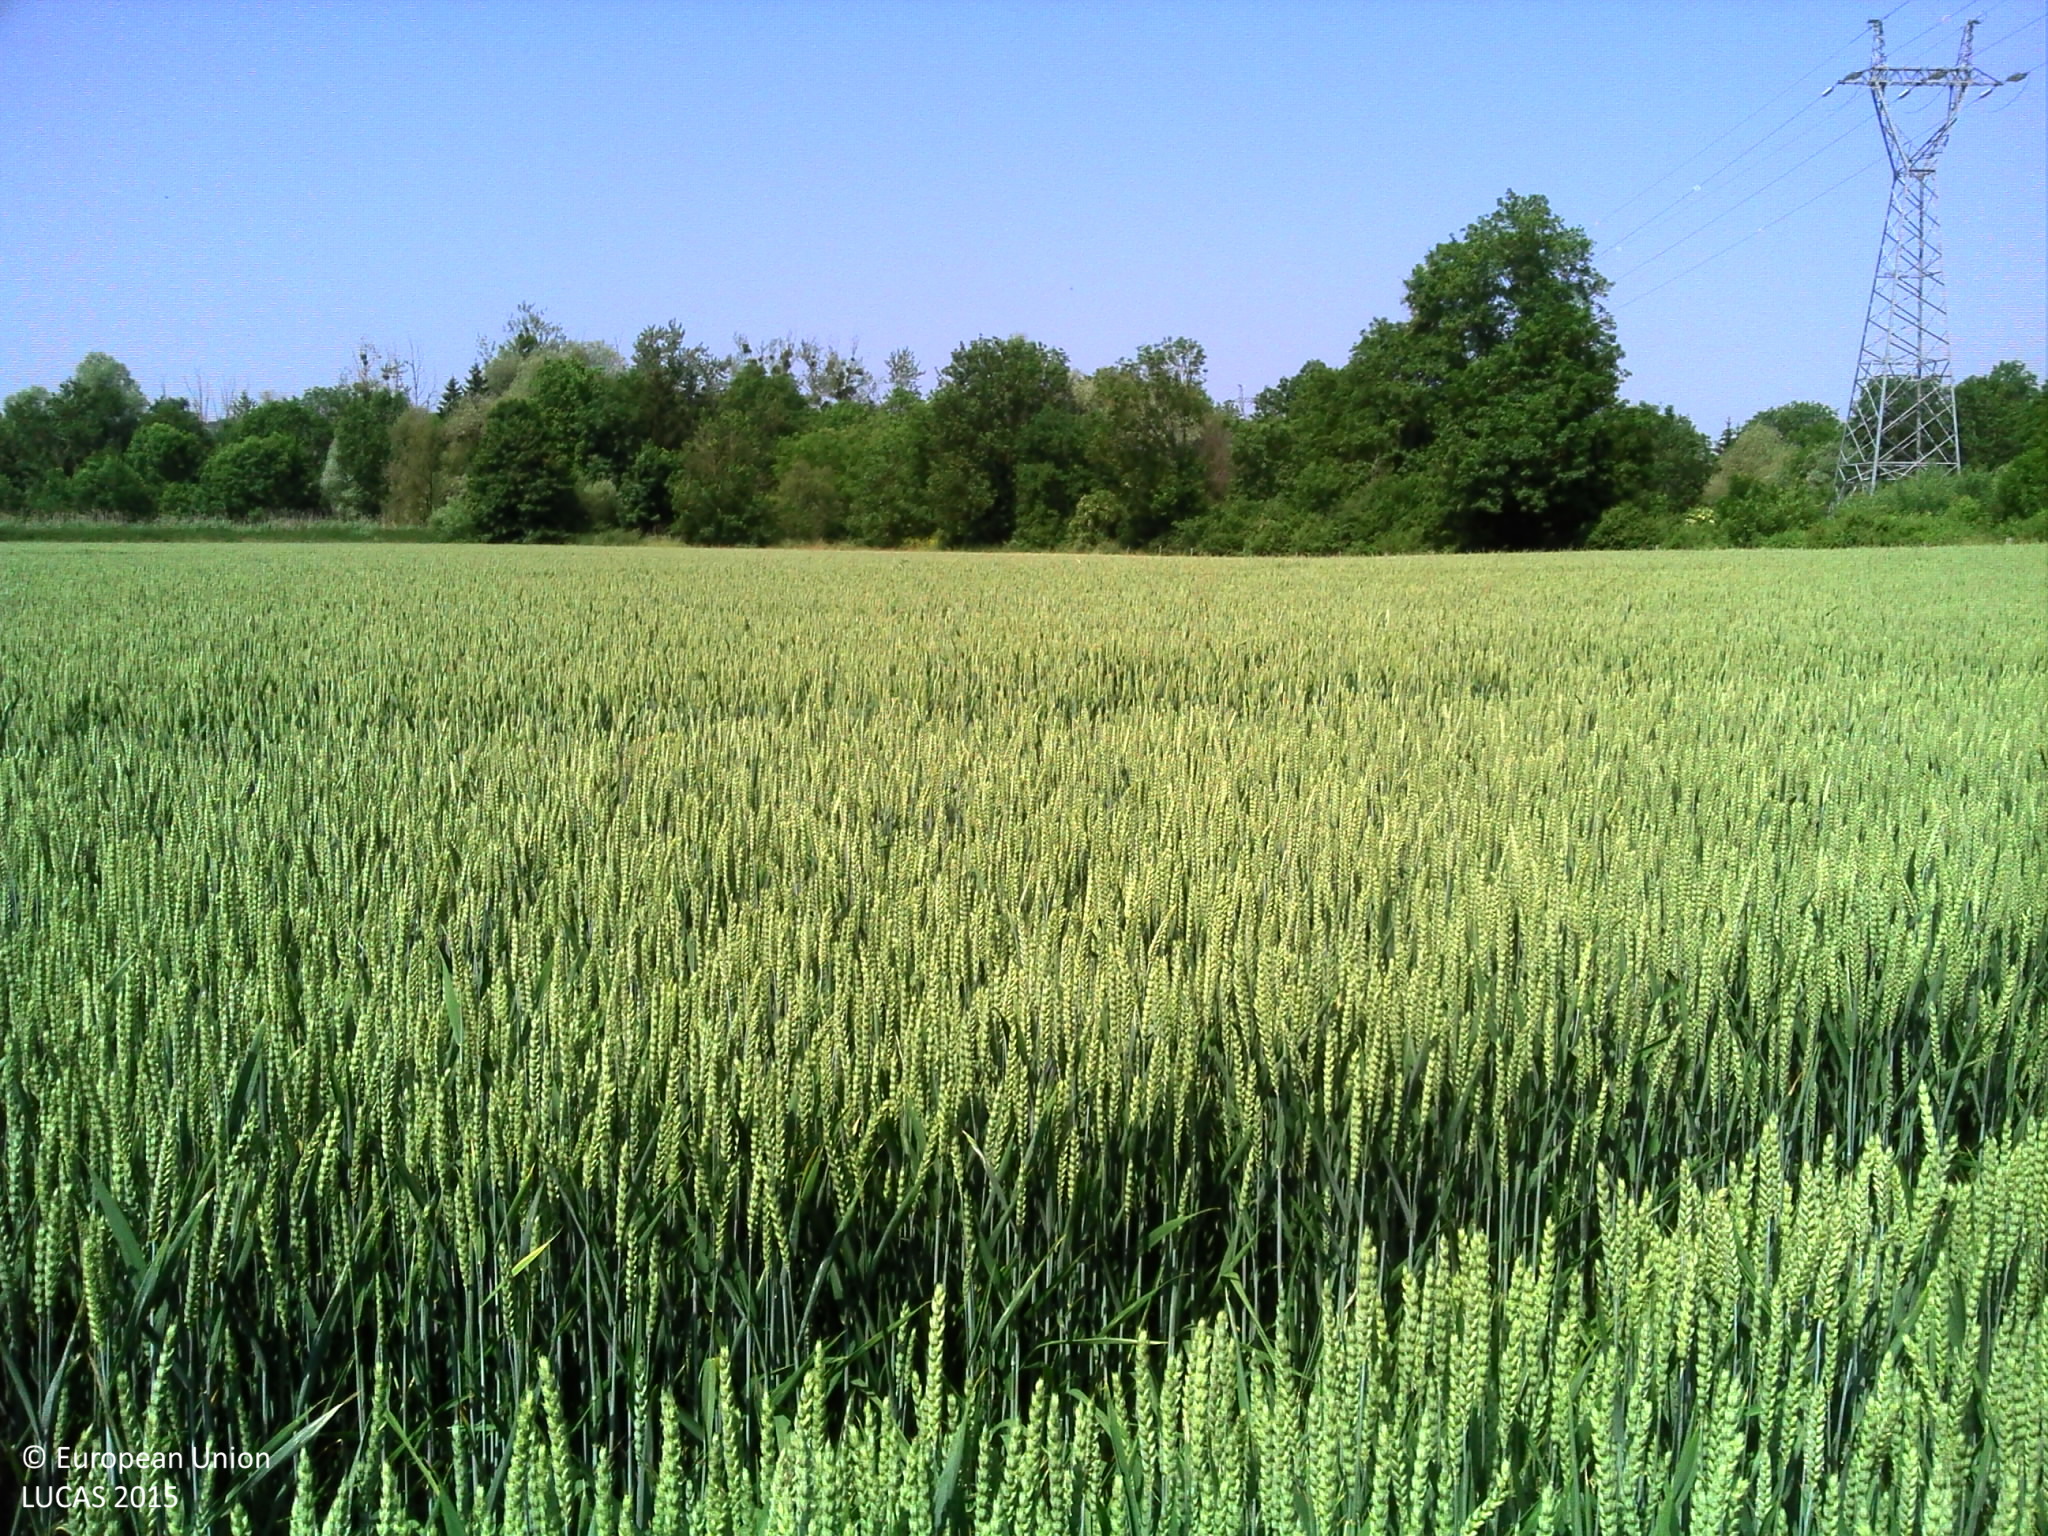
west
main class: Cropland
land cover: Common wheat
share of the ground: > 75 %
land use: Agriculture (excluding fallow land and kitchen gardens)
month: June
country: FR
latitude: 48.4859
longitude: 6.3066
